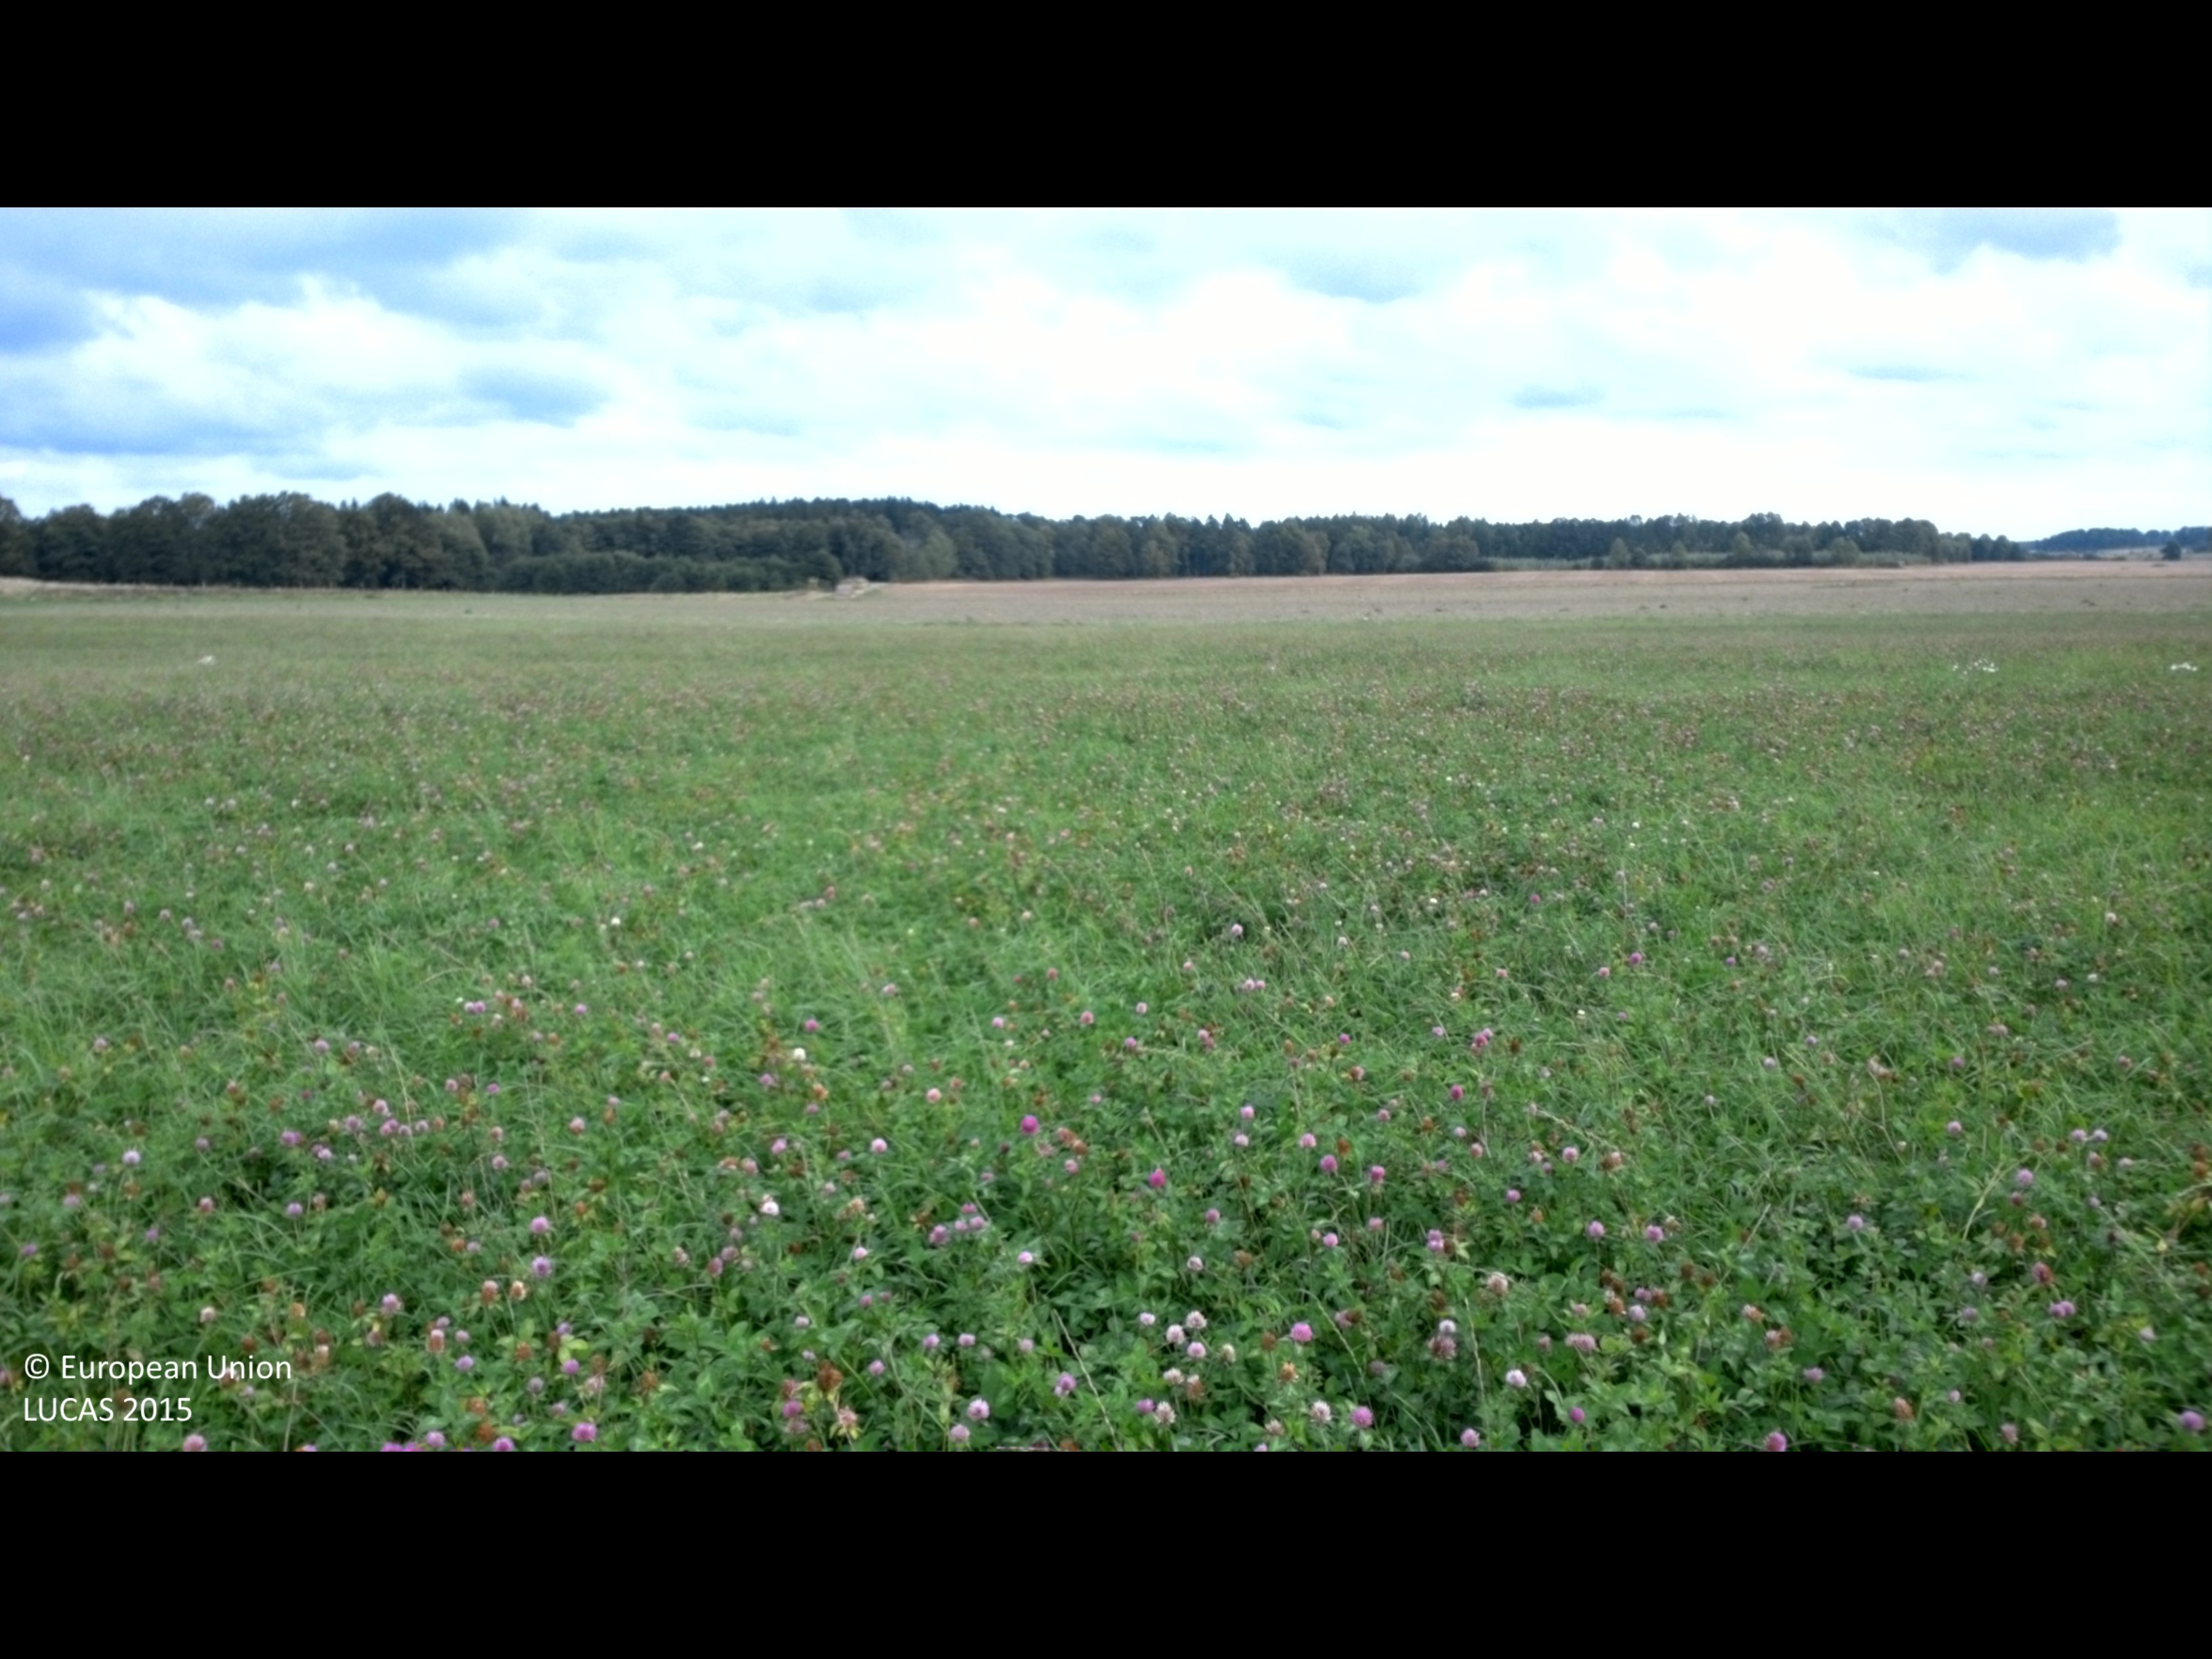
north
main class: Cropland
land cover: Clovers
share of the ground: > 75 %
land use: Agriculture (excluding fallow land and kitchen gardens)
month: September
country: SE
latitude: 56.2141
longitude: 14.0447
